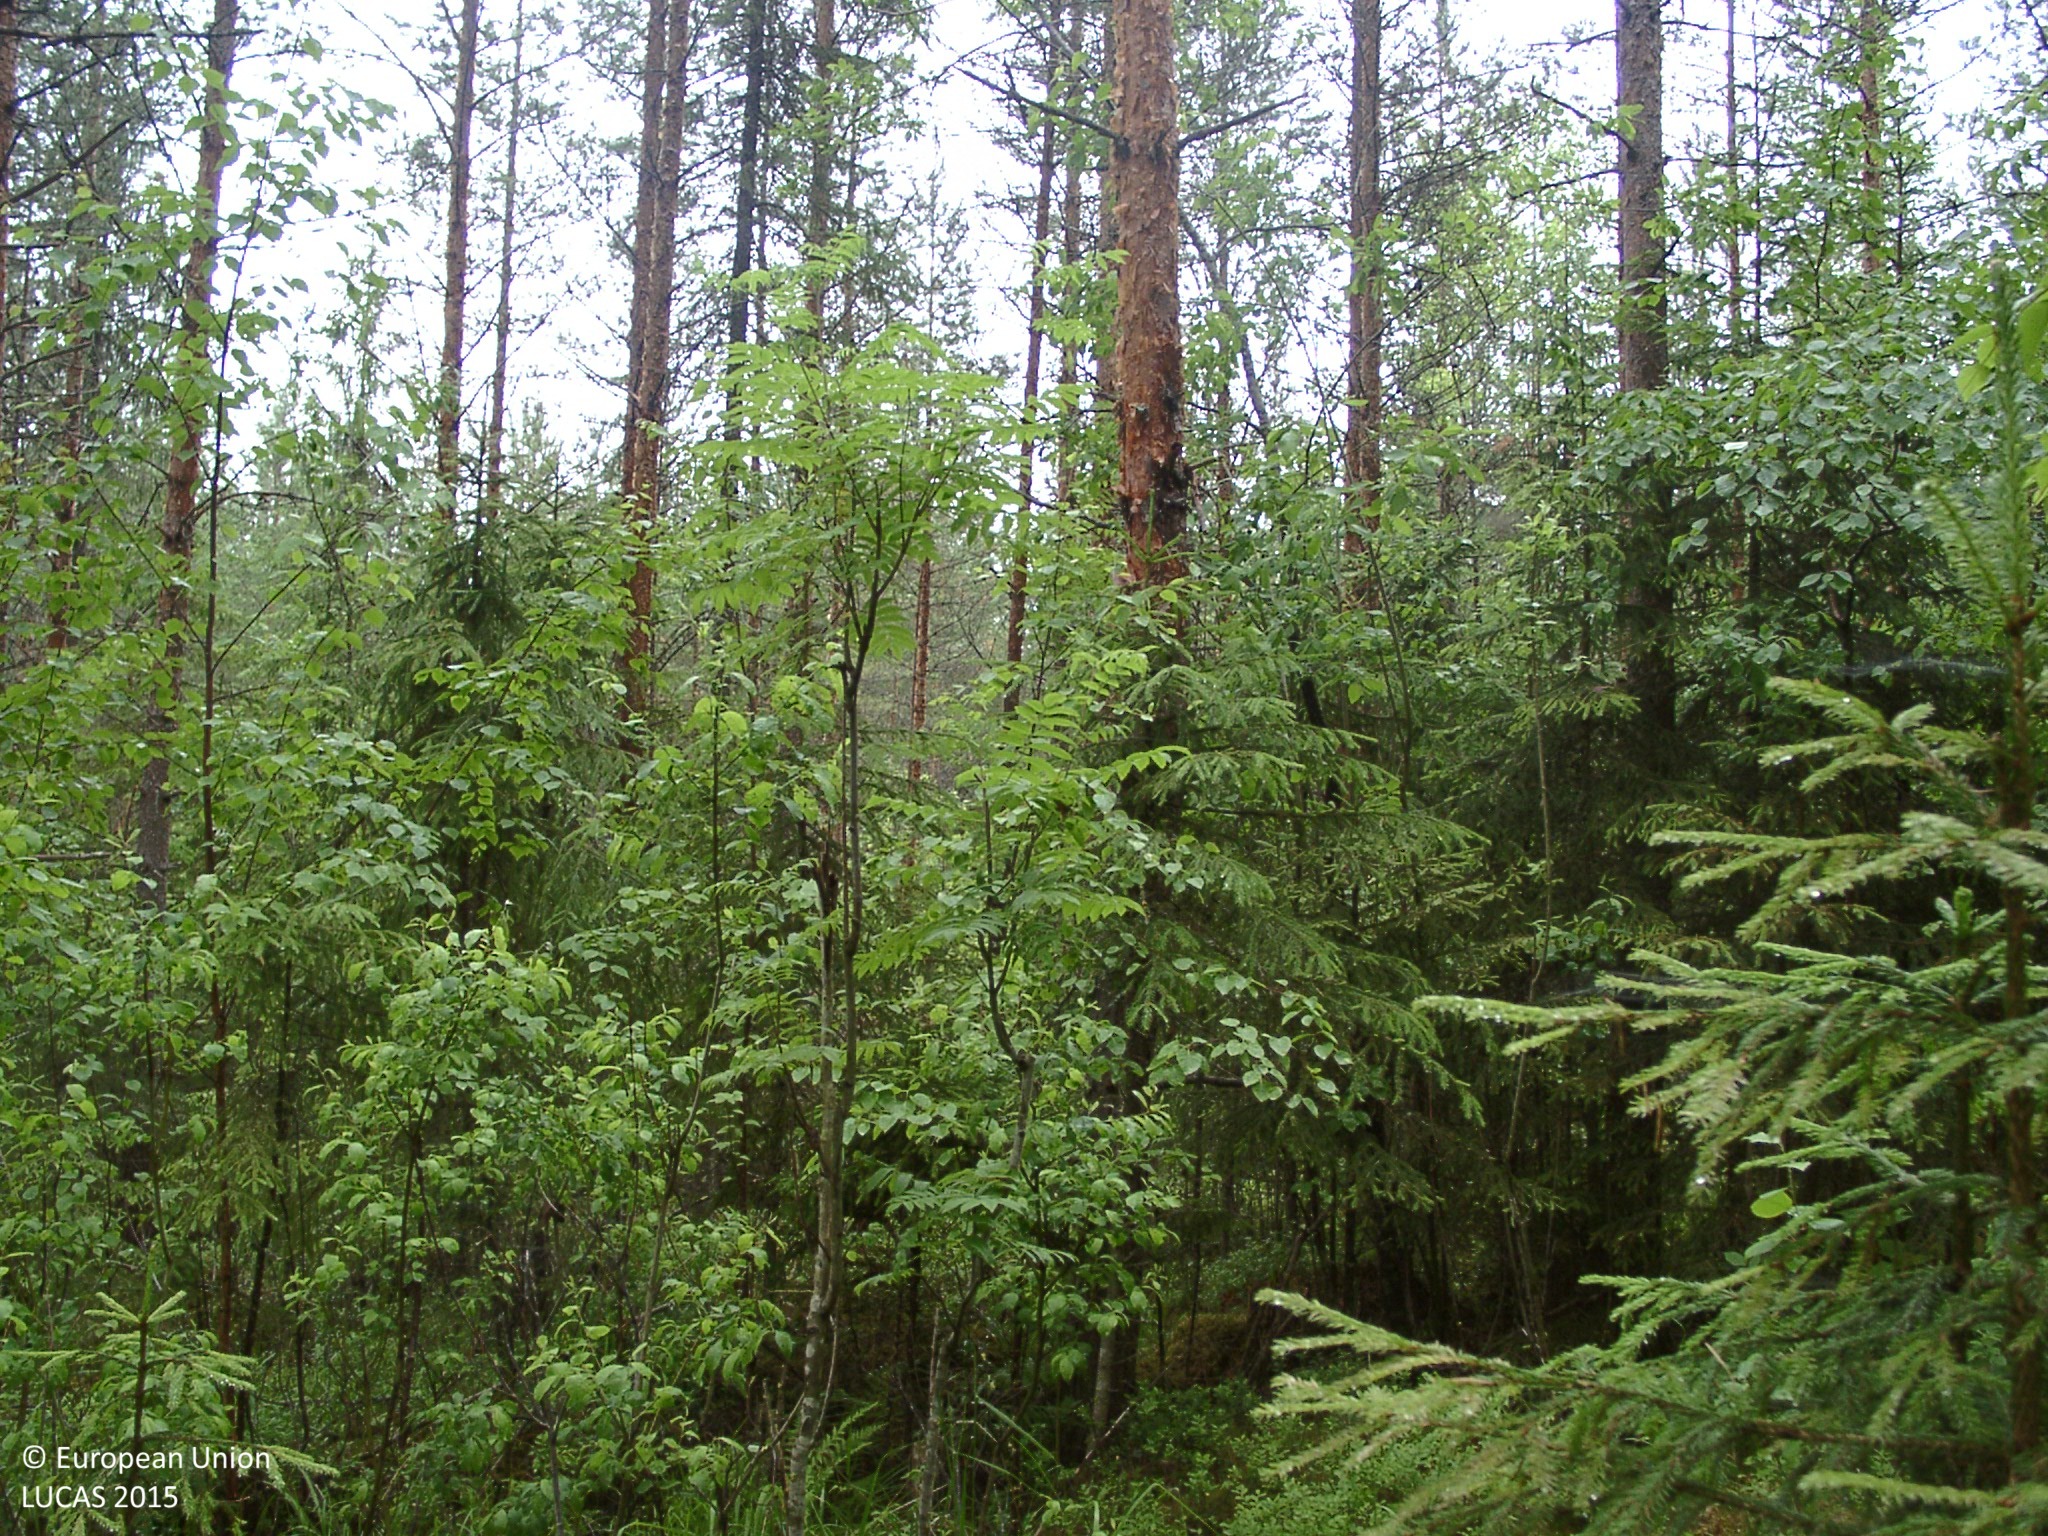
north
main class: Woodland
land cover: Other mixed woodland
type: boreal forest
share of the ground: 50 - 75 %
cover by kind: coniferous forest trees 50 %, broadleaved forest trees 35 %, shrubs 5 %, herbaceous plants 5 %, lichens and mosses 5 %
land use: Semi-natural and natural areas not in use
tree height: > 5 m
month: July
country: FI
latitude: 62.1075
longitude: 25.2274
